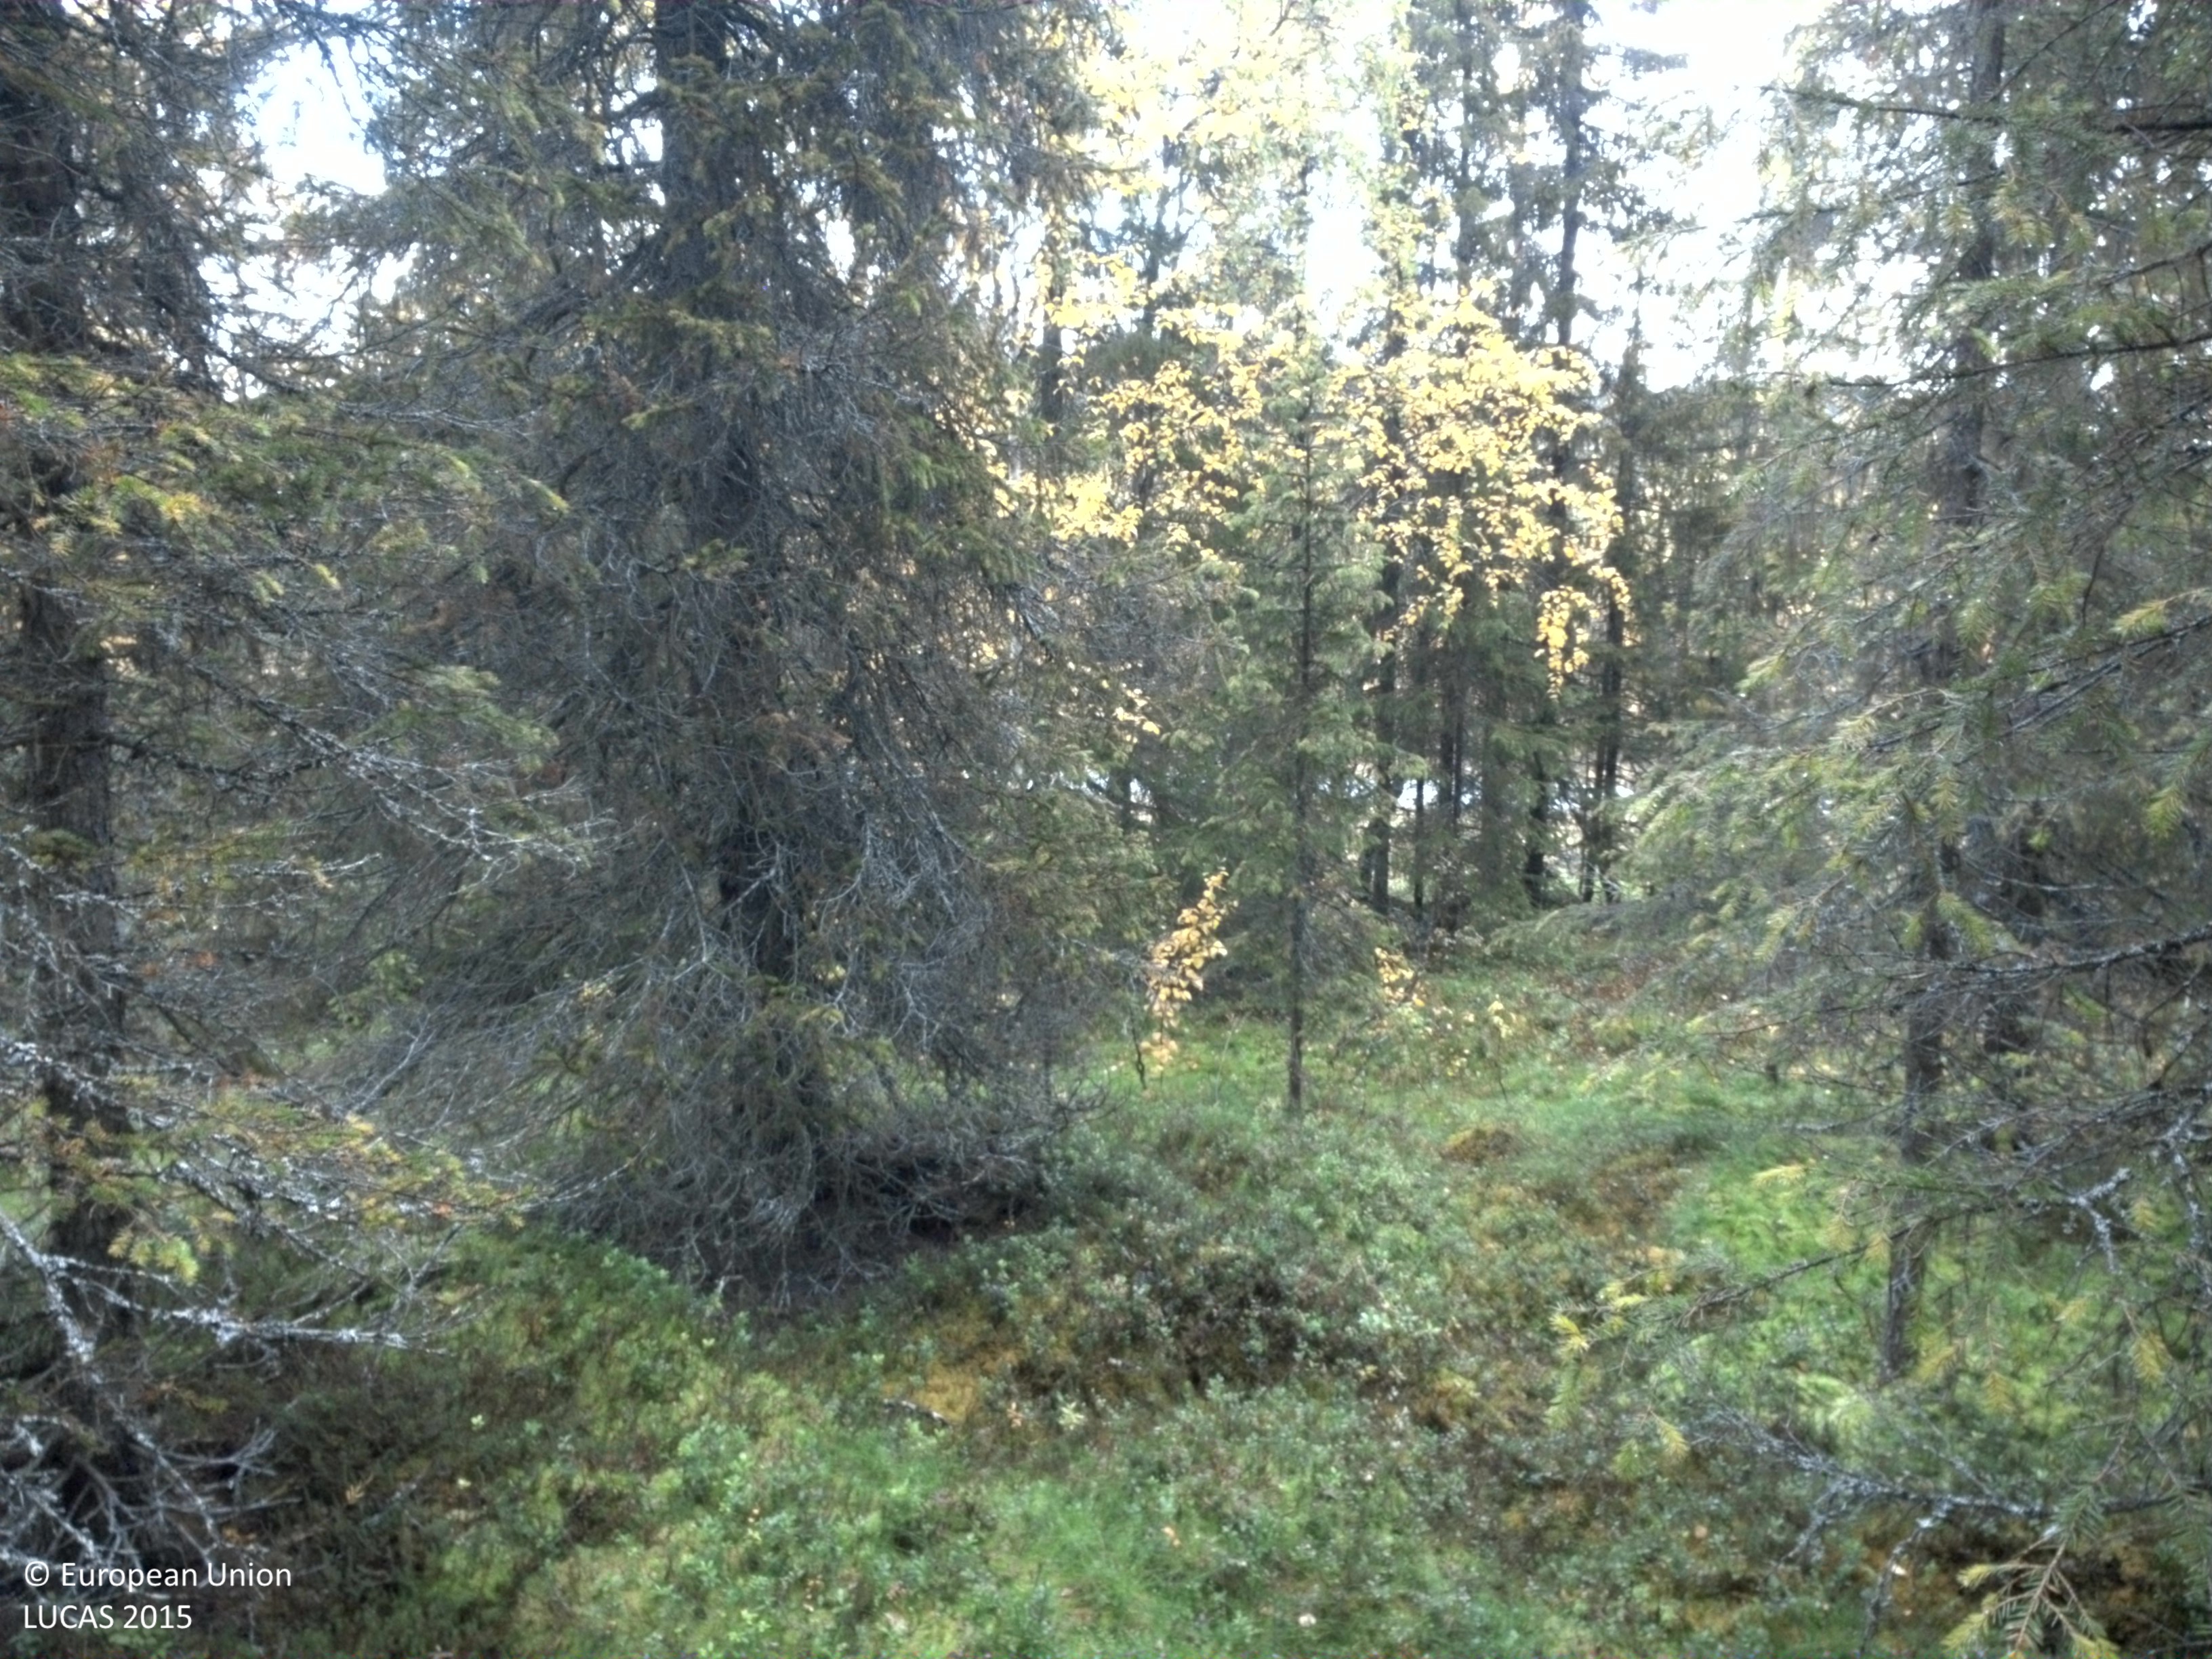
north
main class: Woodland
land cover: Spruce dominated mixed woodland
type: boreal forest
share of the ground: 25 - 50 %
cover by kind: shrubs 45 %, broadleaved forest trees 25 %, coniferous forest trees 10 %, herbaceous plants 10 %, lichens and mosses 10 %
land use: Forestry
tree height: > 5 m
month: September
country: SE
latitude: 65.2035
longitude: 16.6090
